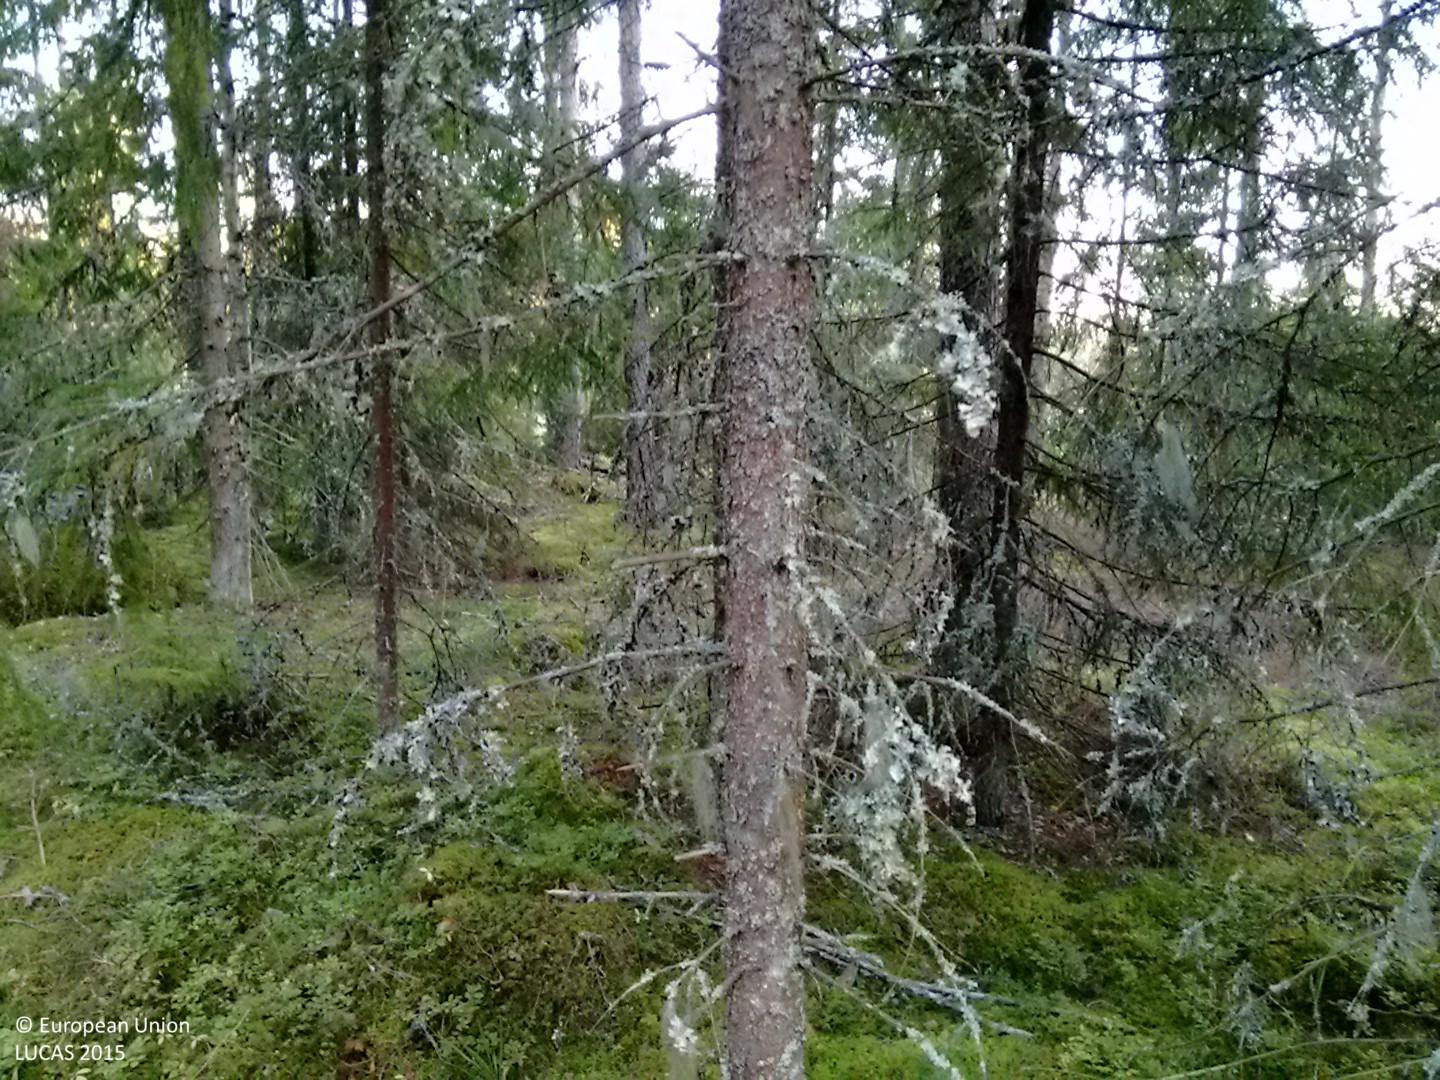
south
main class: Woodland
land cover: Spruce dominated coniferous woodland
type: hemiboreal forest and nemoral coniferous forest and mixed broadleaved-coniferous forest
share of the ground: > 75 %
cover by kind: coniferous forest trees 70 %, shrubs 15 %, herbaceous plants 10 %, broadleaved forest trees 5 %
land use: Forestry
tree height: > 5 m
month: September
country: FI
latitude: 60.9051
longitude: 21.8017
